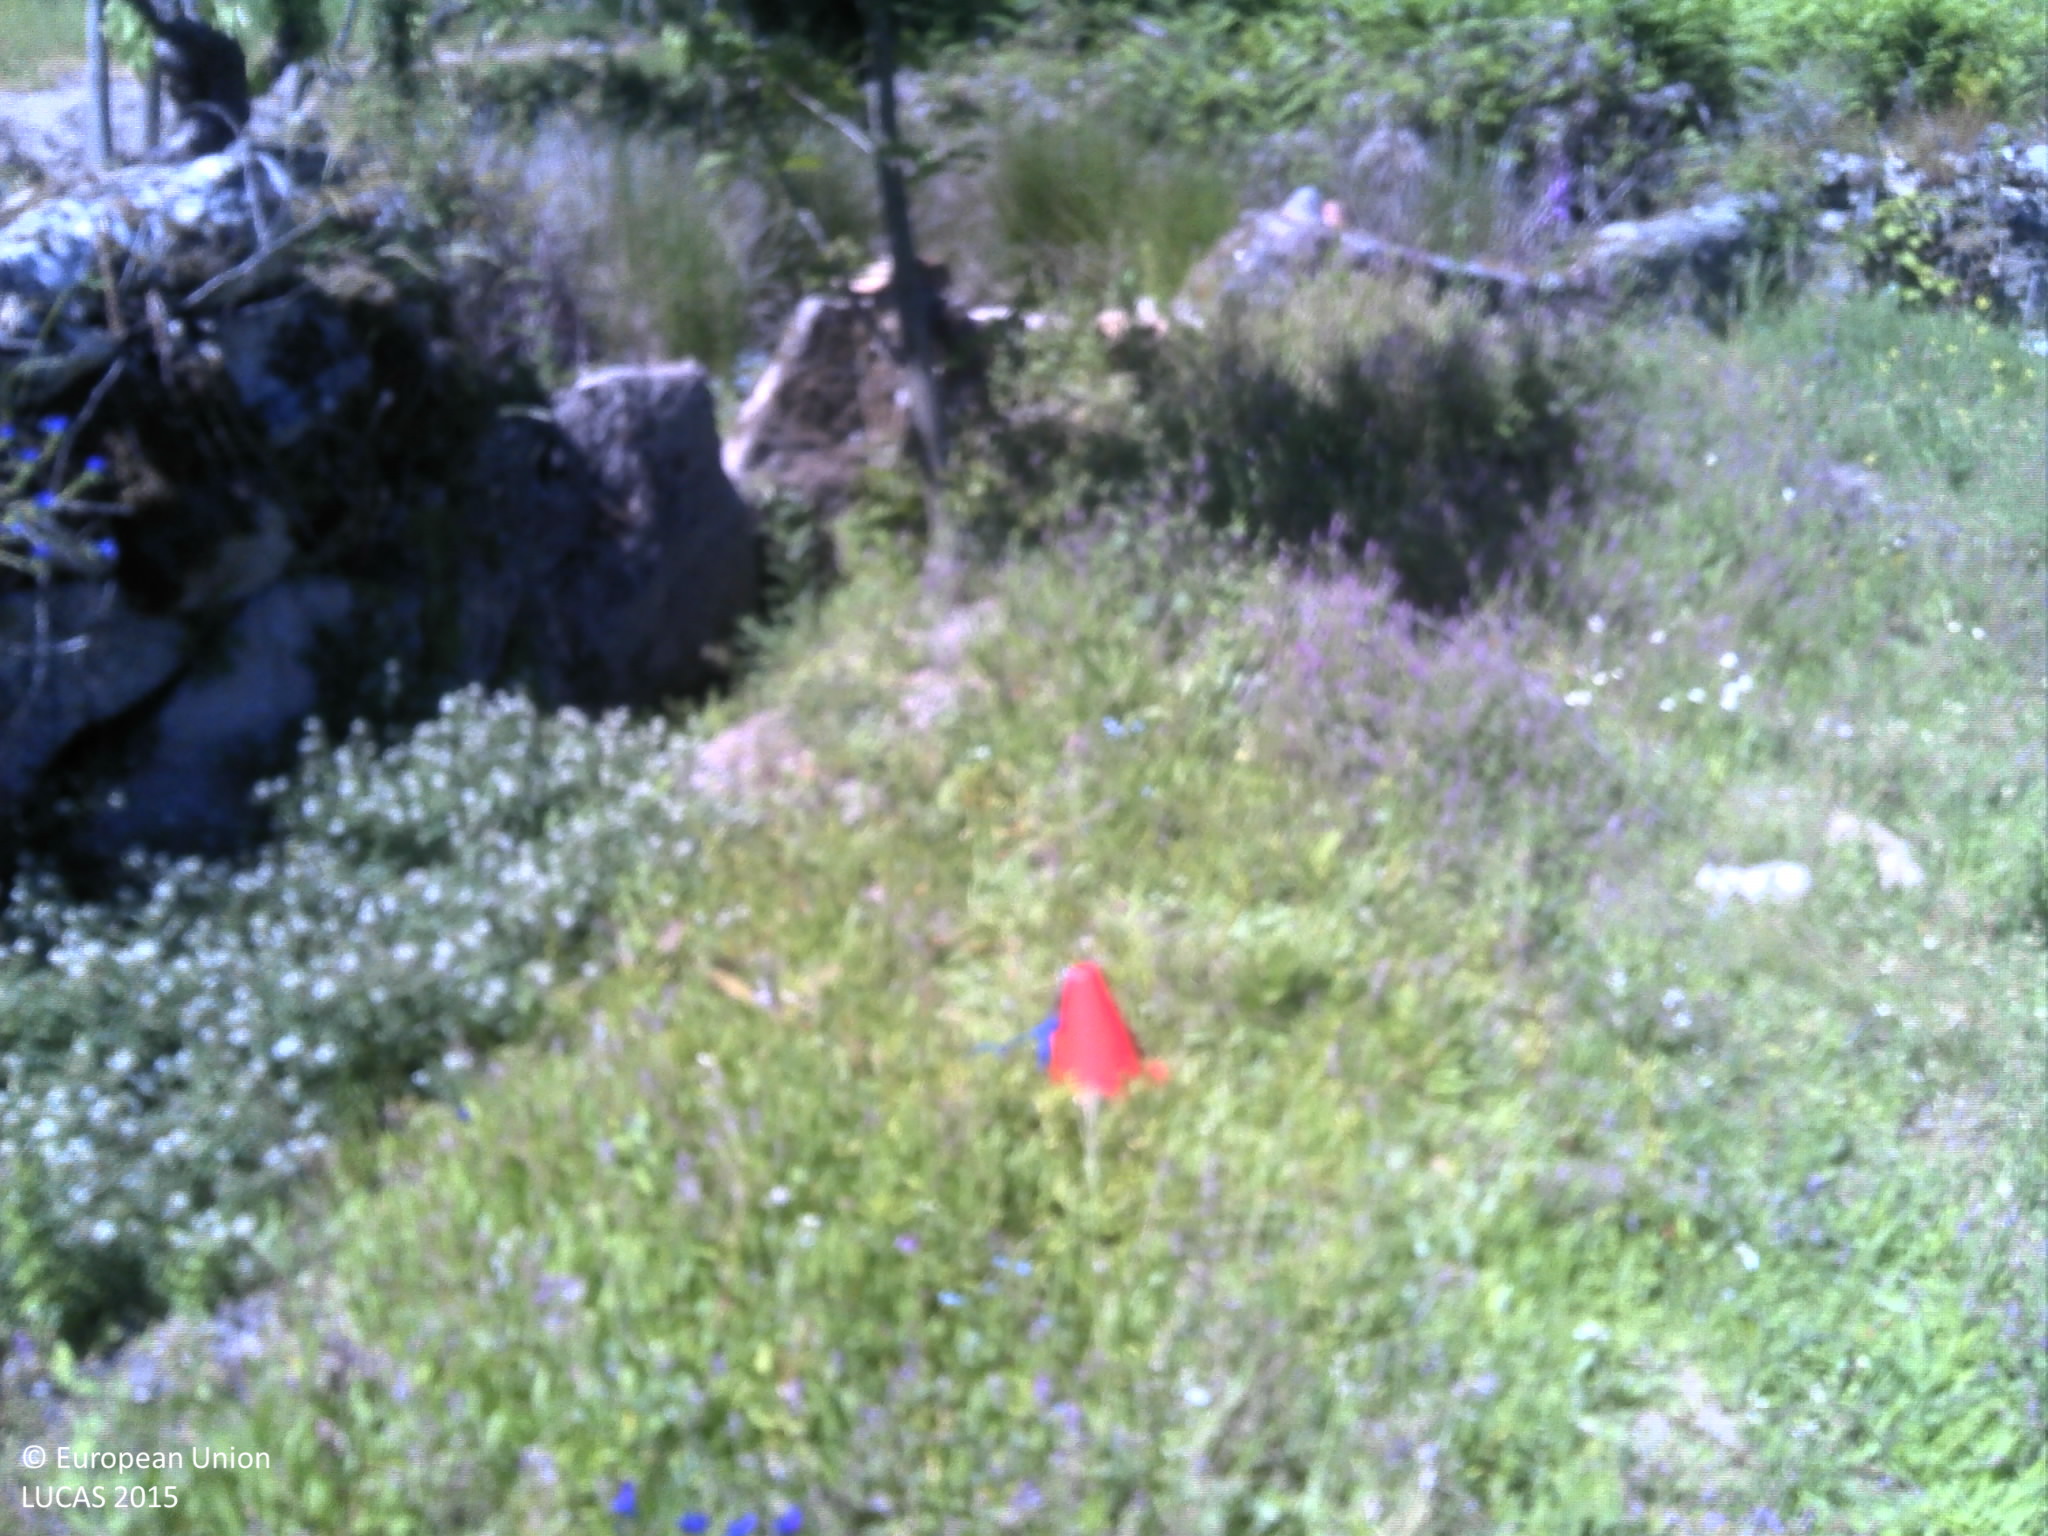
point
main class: Grassland
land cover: Grassland without tree/shrub cover
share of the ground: > 75 %
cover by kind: herbaceous plants 95 %, unconsolidated bare surface 5 %
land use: Agriculture (excluding fallow land and kitchen gardens)
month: May
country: PT
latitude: 40.5547
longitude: -7.7497
